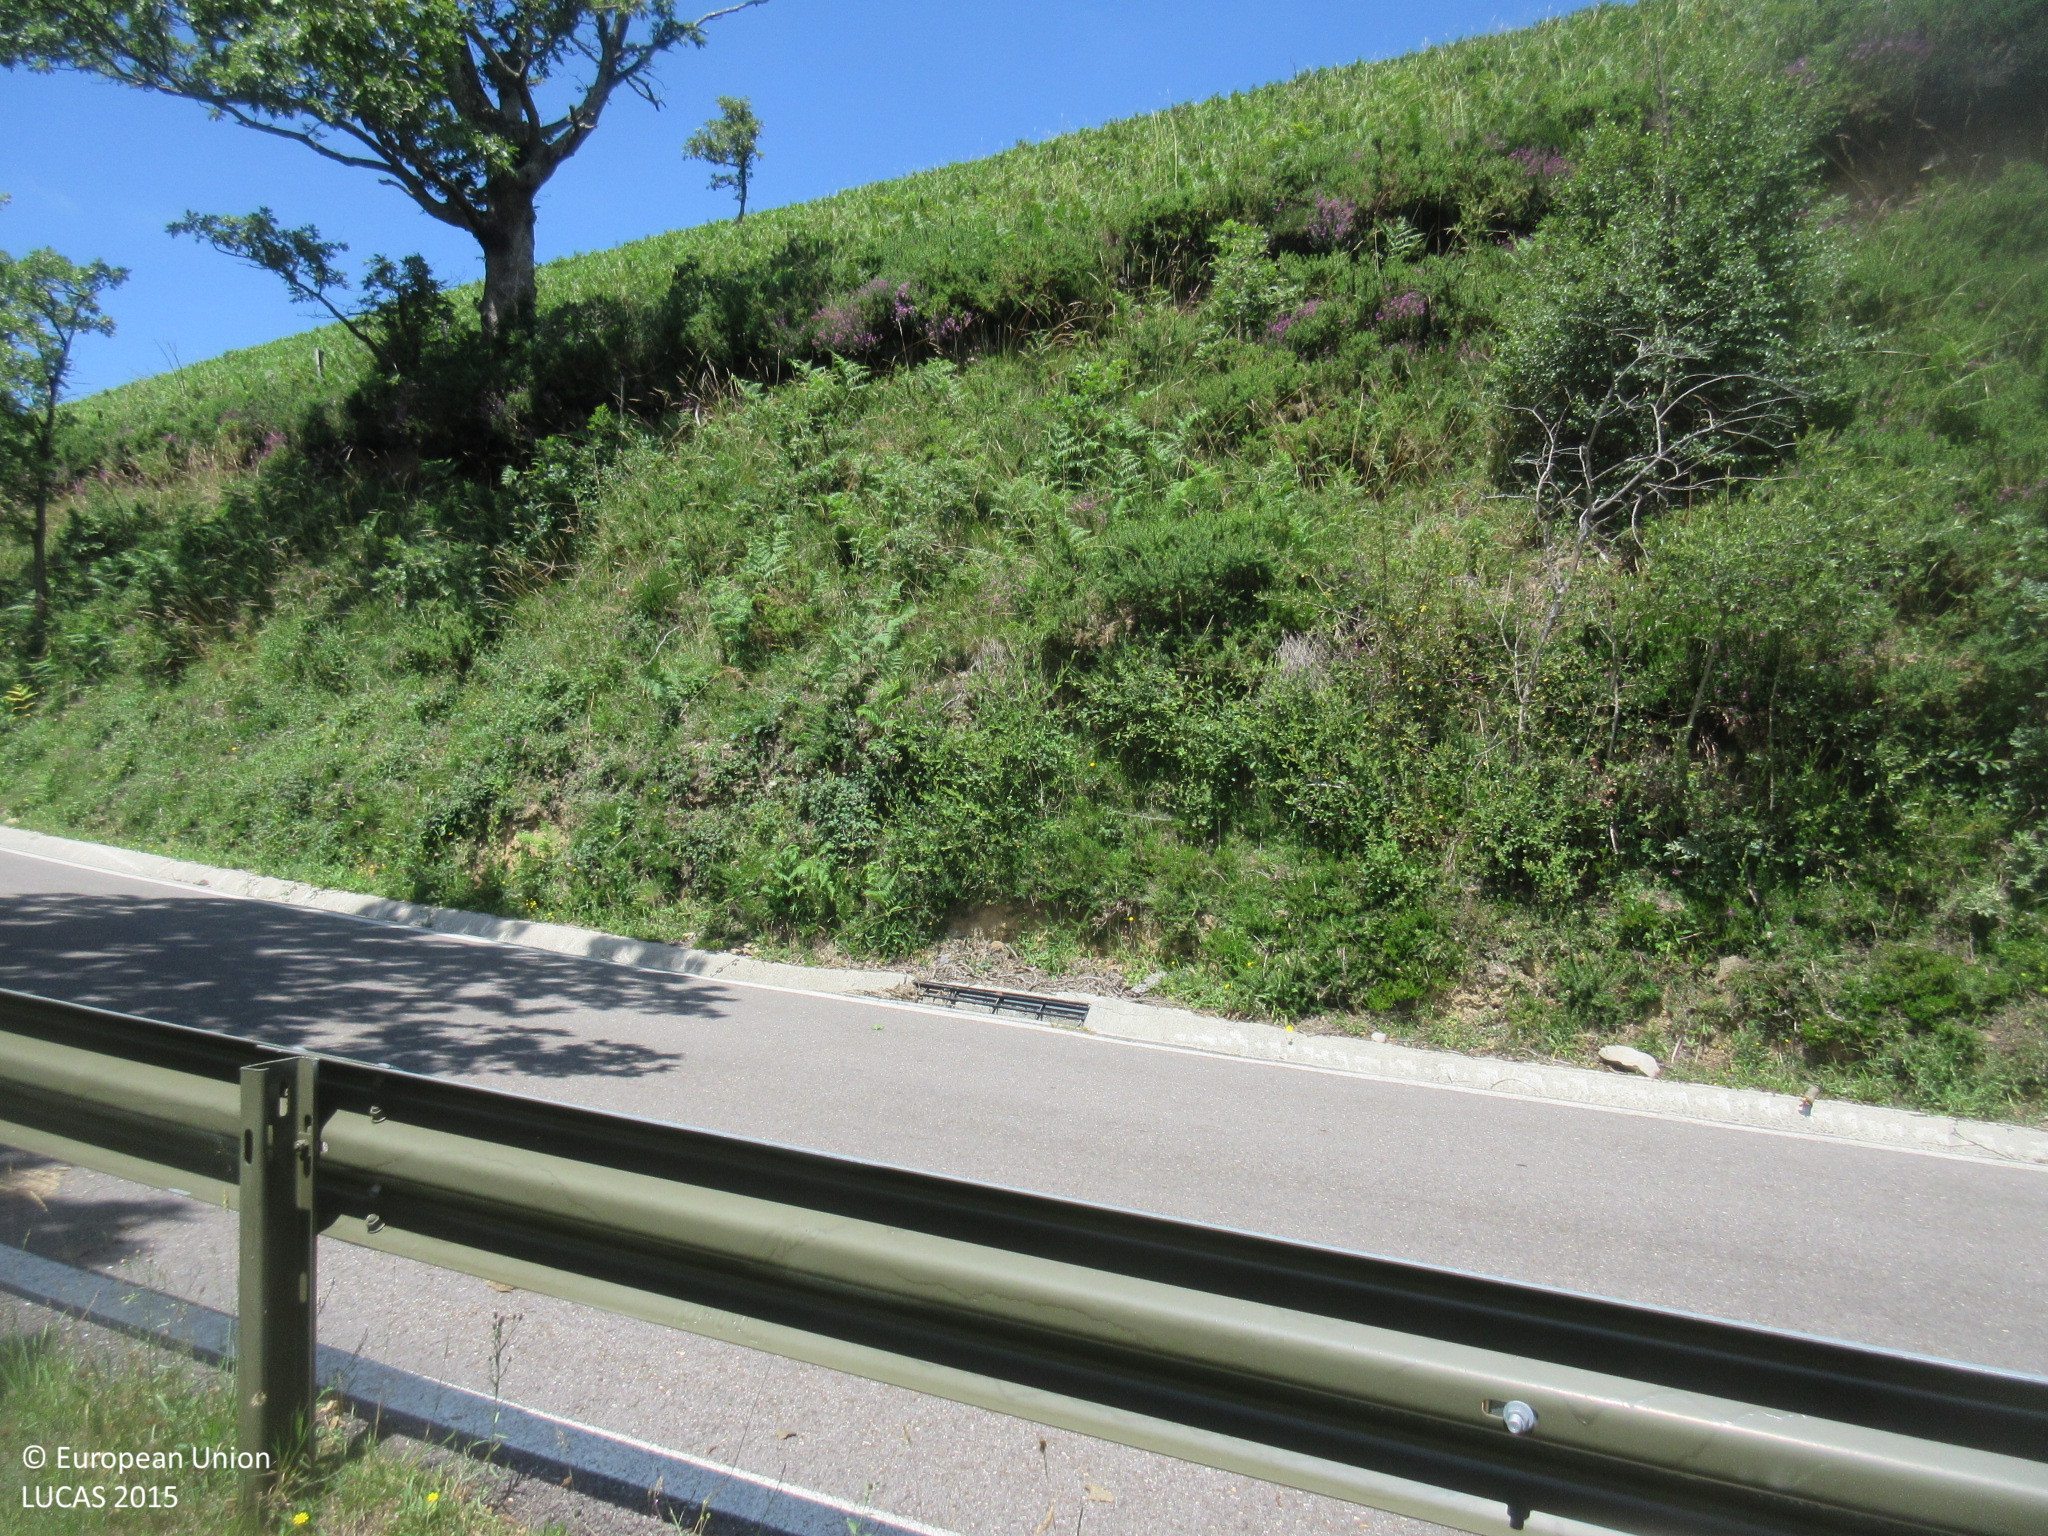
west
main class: Woodland
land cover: Broadleaved woodland
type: acidophilous oak and oak-birch forest
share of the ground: 25 - 50 %
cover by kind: shrubs 70 %, broadleaved forest trees 30 %
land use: Forestry
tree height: > 5 m
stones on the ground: < 10 %
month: July
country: ES
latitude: 43.1779
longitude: -3.5878
